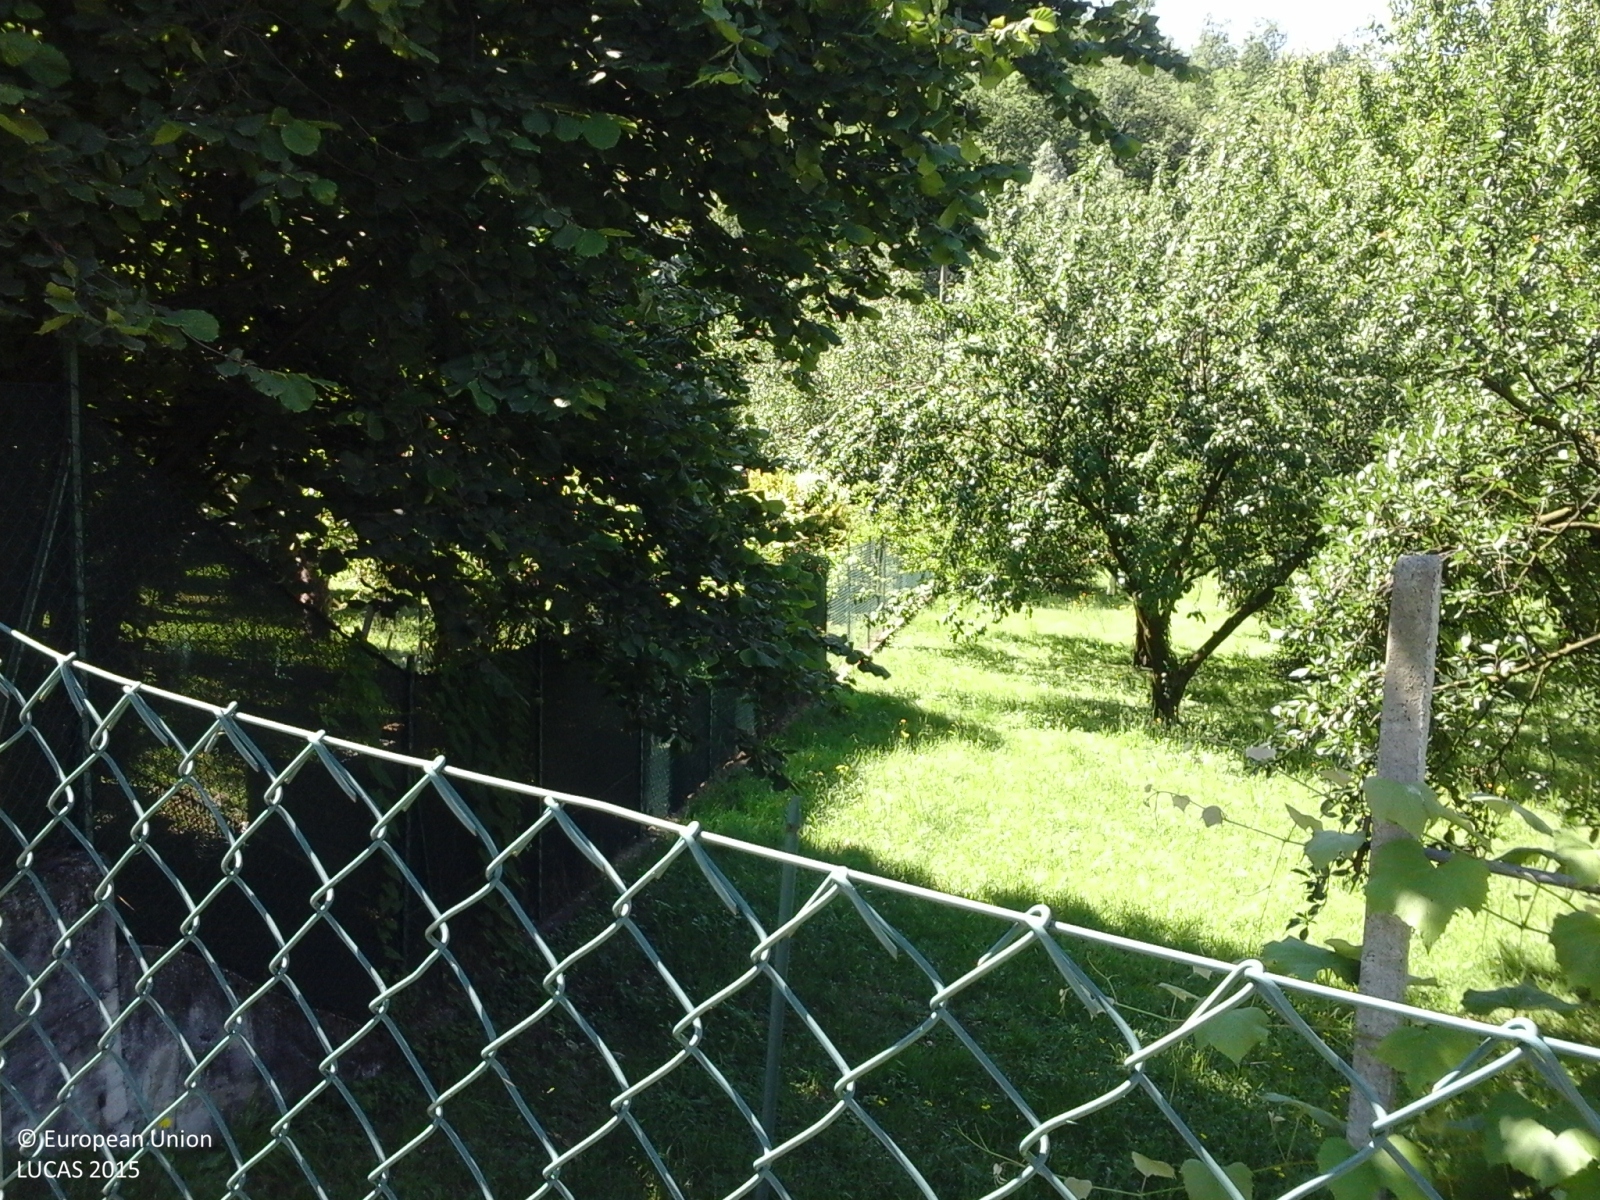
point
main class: Woodland
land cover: Broadleaved woodland
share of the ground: 25 - 50 %
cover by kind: broadleaved forest trees 50 %, herbaceous plants 50 %
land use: Residential
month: June
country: IT
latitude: 45.8926
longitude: 8.6746
